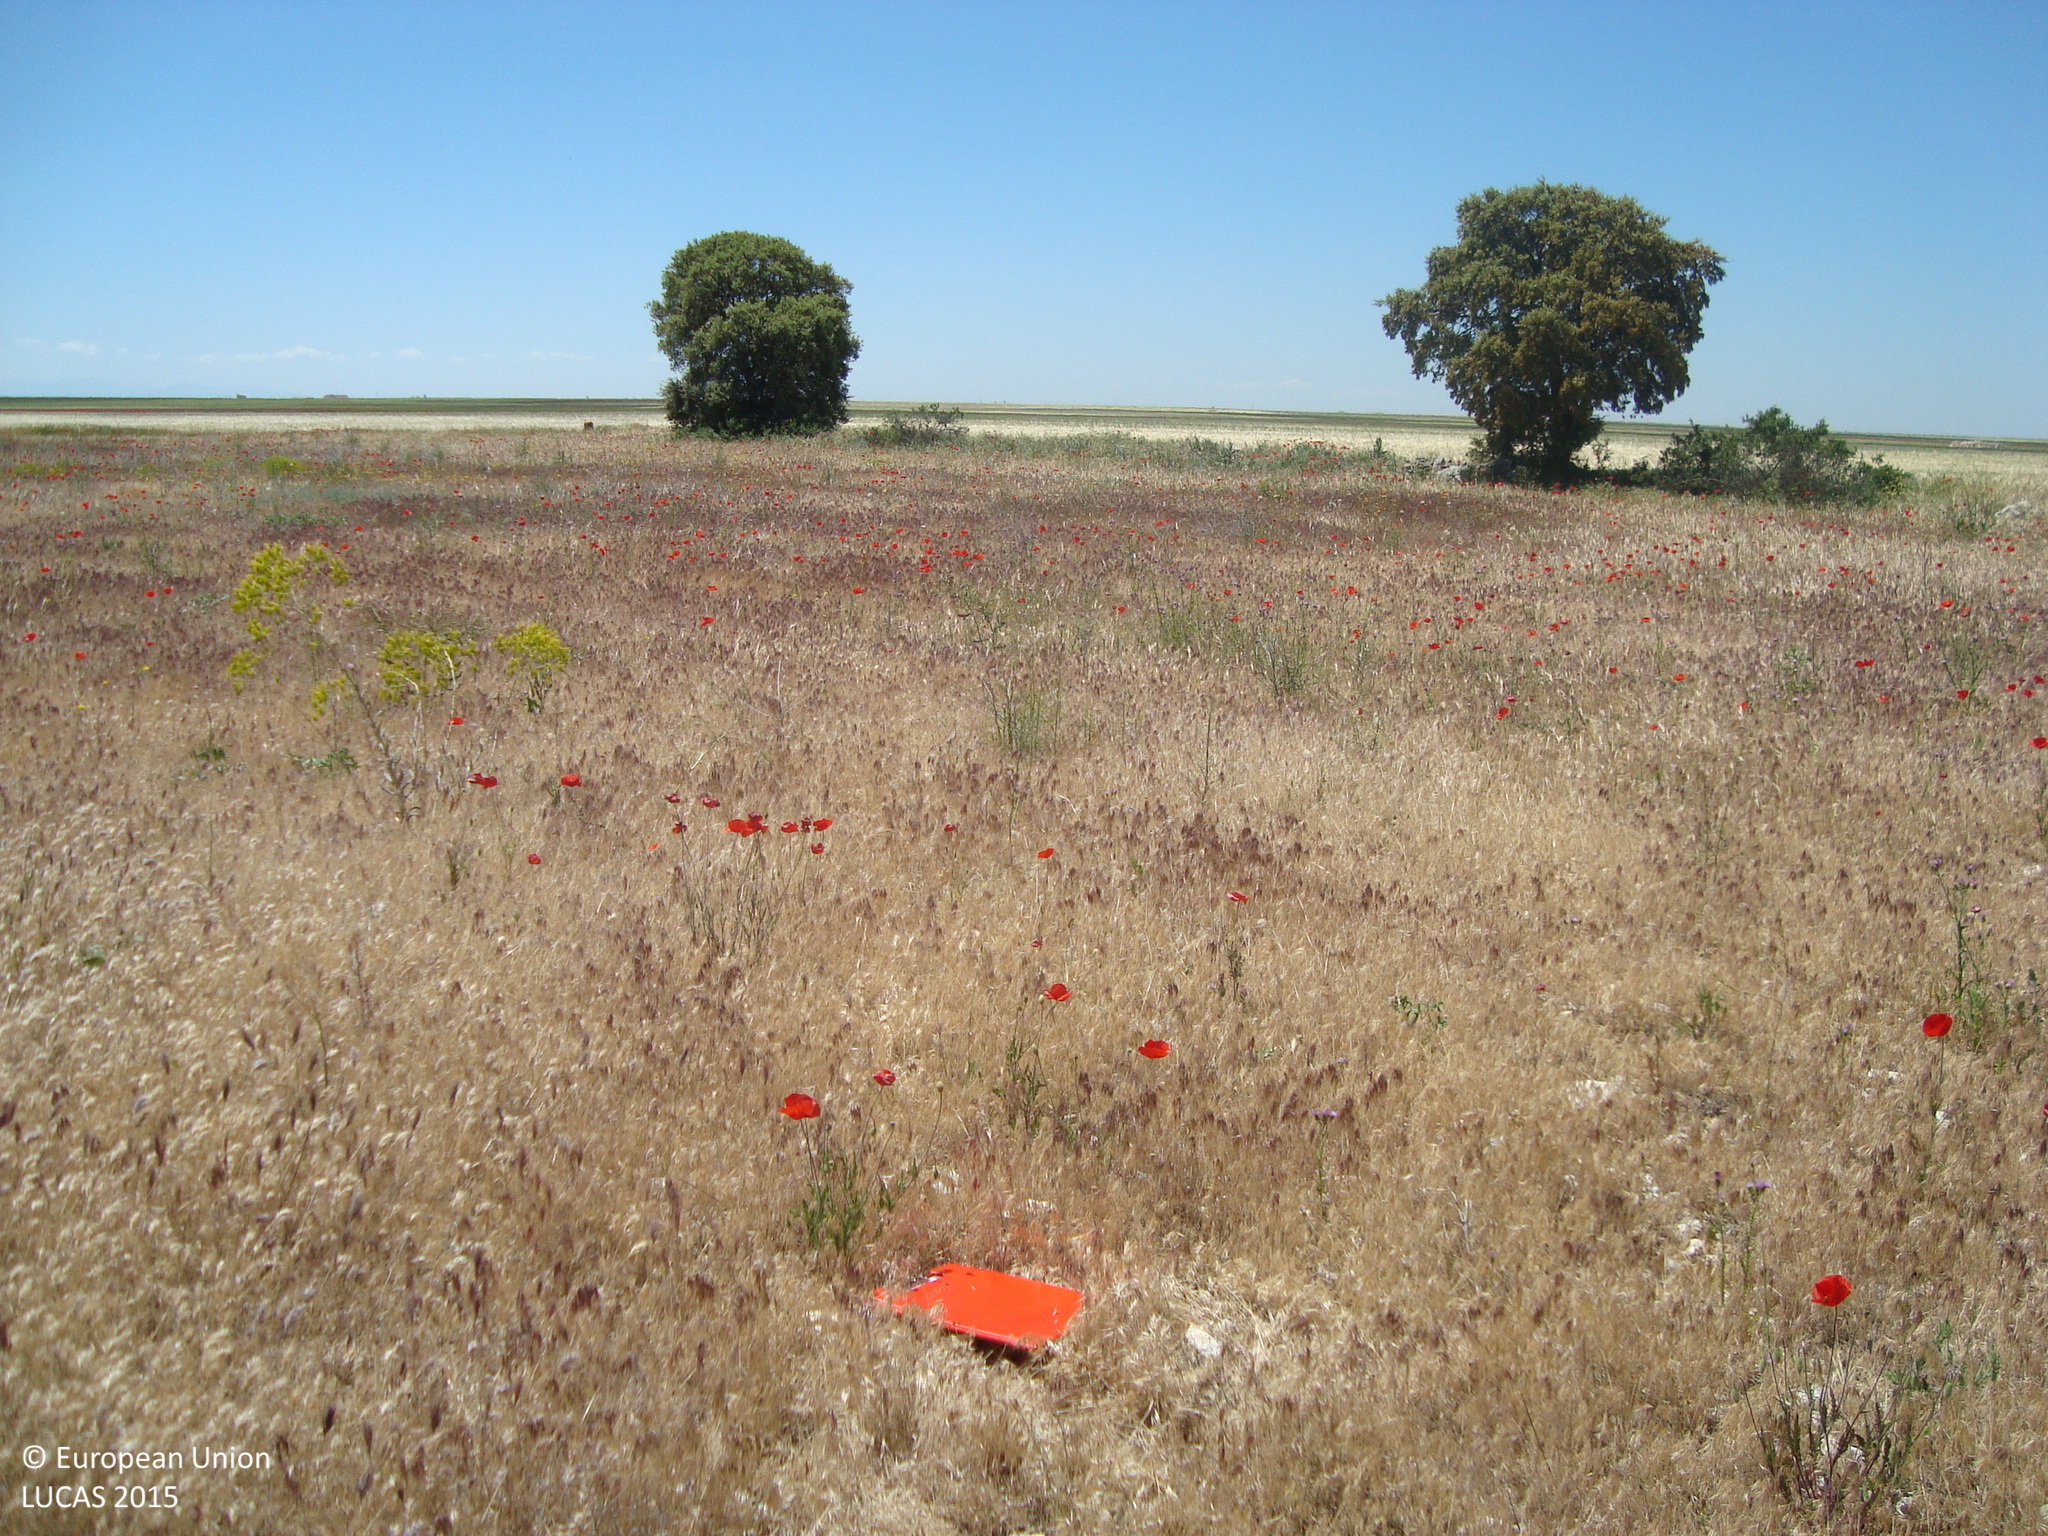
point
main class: Grassland
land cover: Spontaneously vegetated surfaces
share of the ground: > 75 %
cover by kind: herbaceous plants 90 %, unconsolidated bare surface 10 %
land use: Abandoned areas
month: May
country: ES
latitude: 41.5392
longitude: -4.1911
